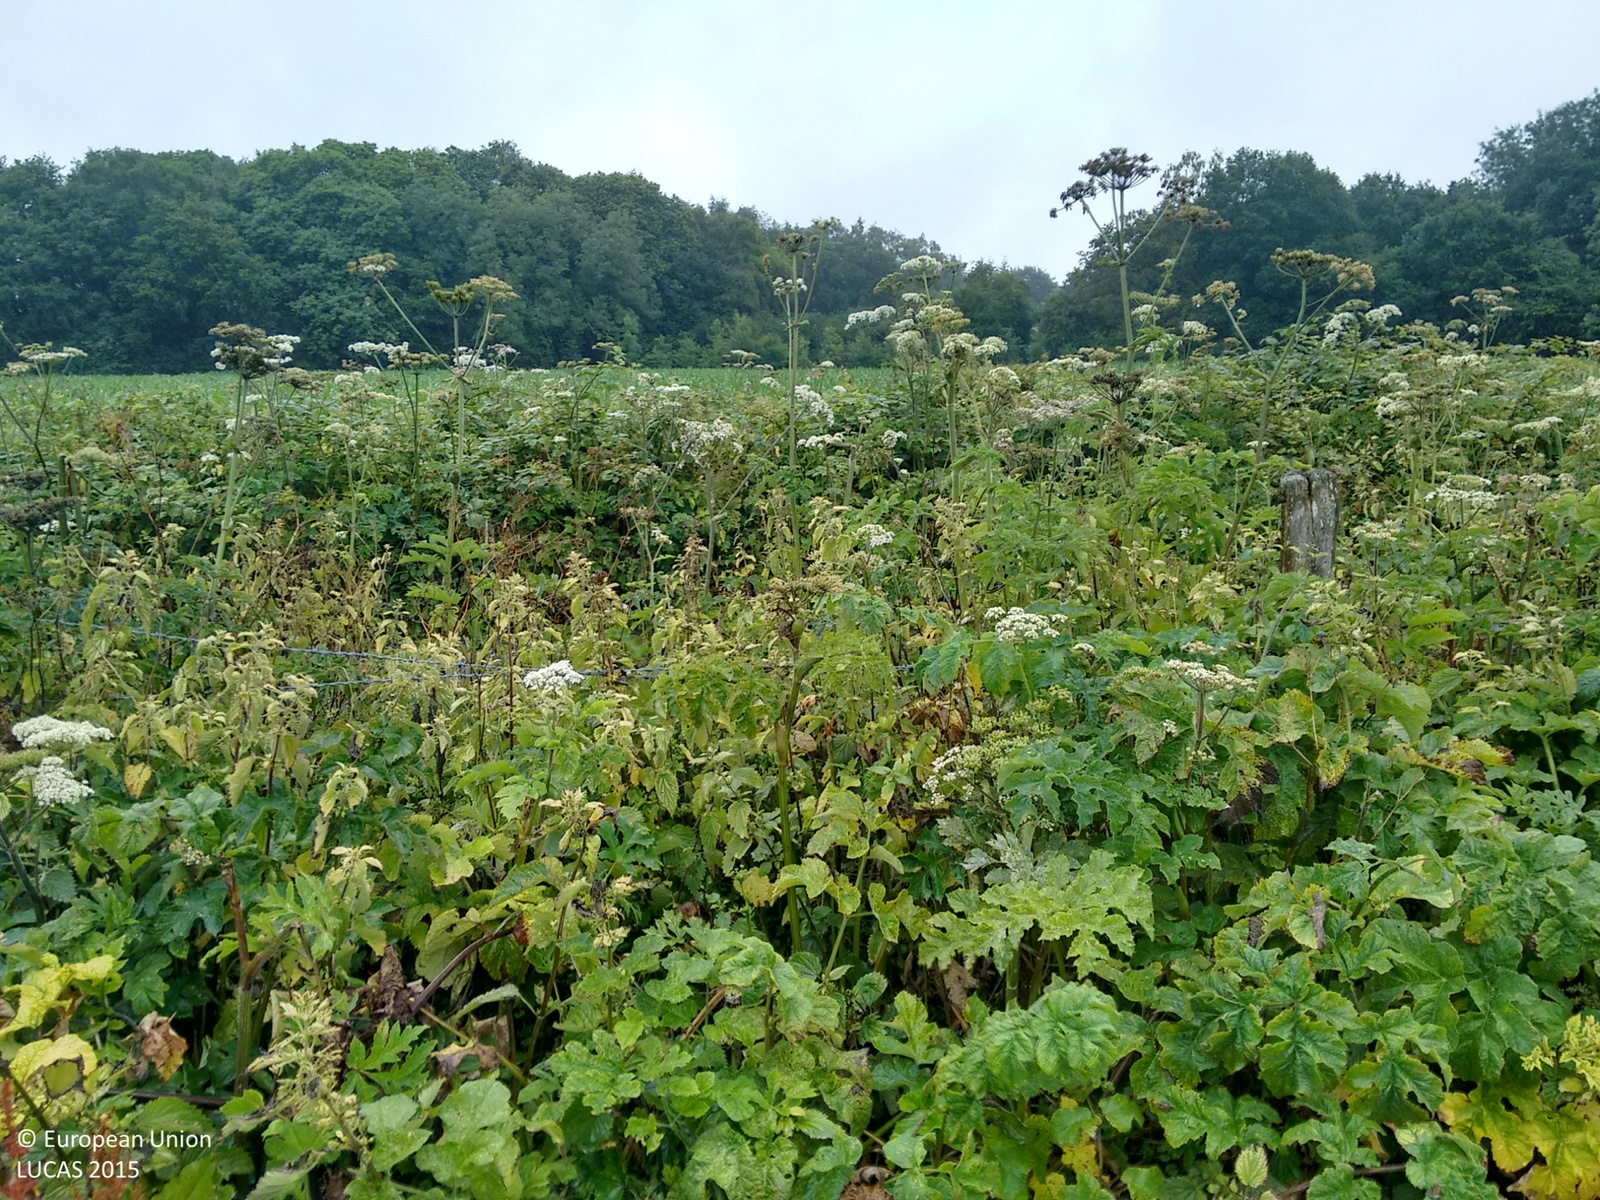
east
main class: Cropland
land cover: Maize
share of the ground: 50 - 75 %
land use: Agriculture (excluding fallow land and kitchen gardens)
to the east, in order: Maize; Grass margins; Managed hedges; Tracks; Managed hedges; Grass margins; Maize; Broadleaved woodland
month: July
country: GB
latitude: 51.1912
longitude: -1.0195
